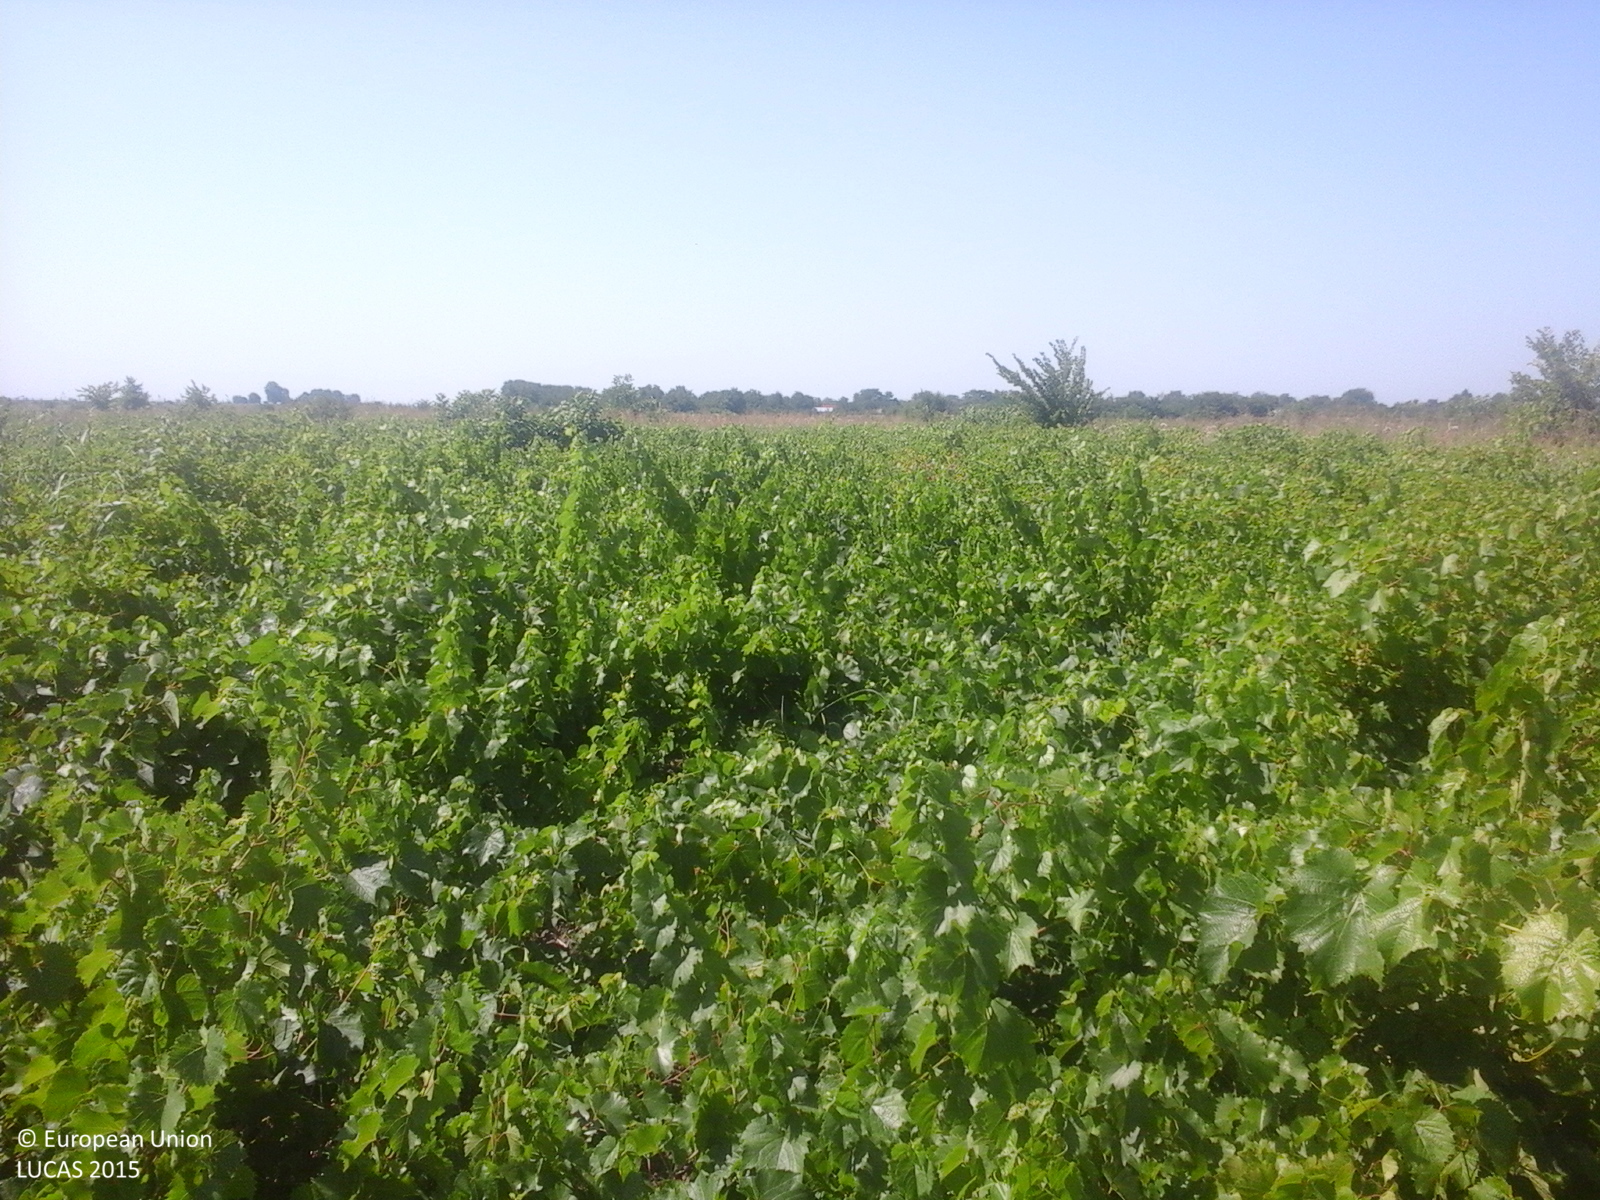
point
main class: Cropland
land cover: Vineyards
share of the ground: > 75 %
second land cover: Other bare soil
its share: > 75 %
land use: Agriculture (excluding fallow land and kitchen gardens)
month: July
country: RO
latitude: 44.3017
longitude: 27.1915
